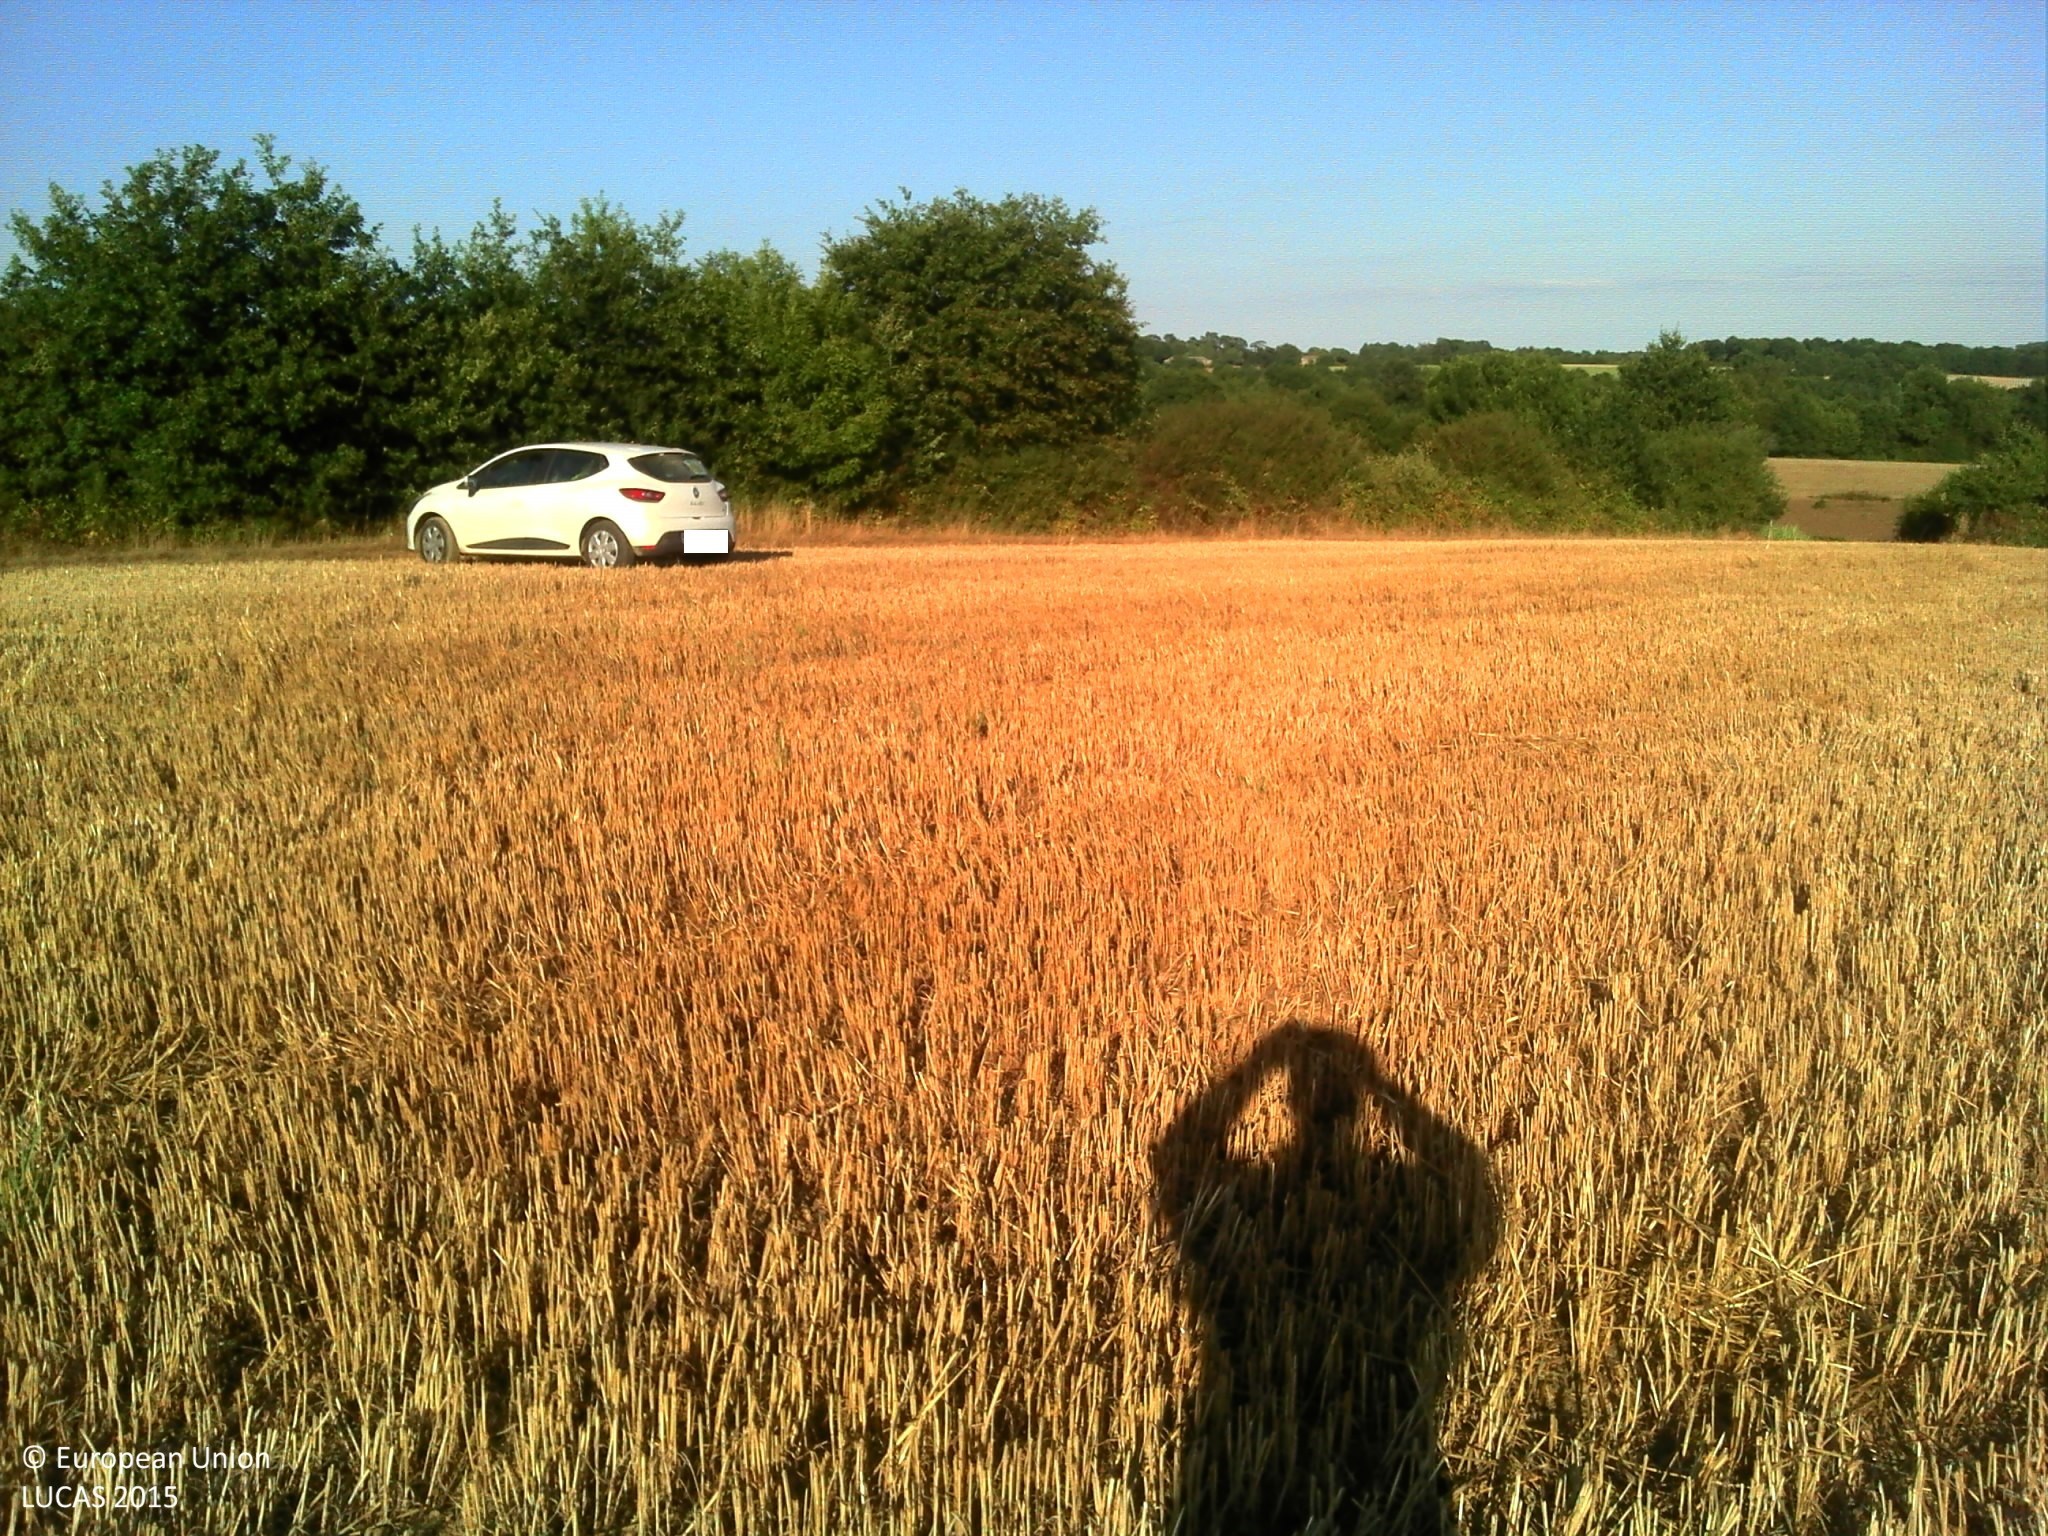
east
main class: Cropland
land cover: Common wheat
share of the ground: > 75 %
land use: Agriculture (excluding fallow land and kitchen gardens)
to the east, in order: Common wheat; Tracks; Abandoned hedges; Common wheat; Abandoned hedges; Maize; Fences; Grassland without tree/shrub cover; Abandoned hedges; Grassland without tree/shrub cover; Abandoned hedges; Grassland without tree/shrub cover
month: August
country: FR
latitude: 46.6439
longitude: -1.0995
